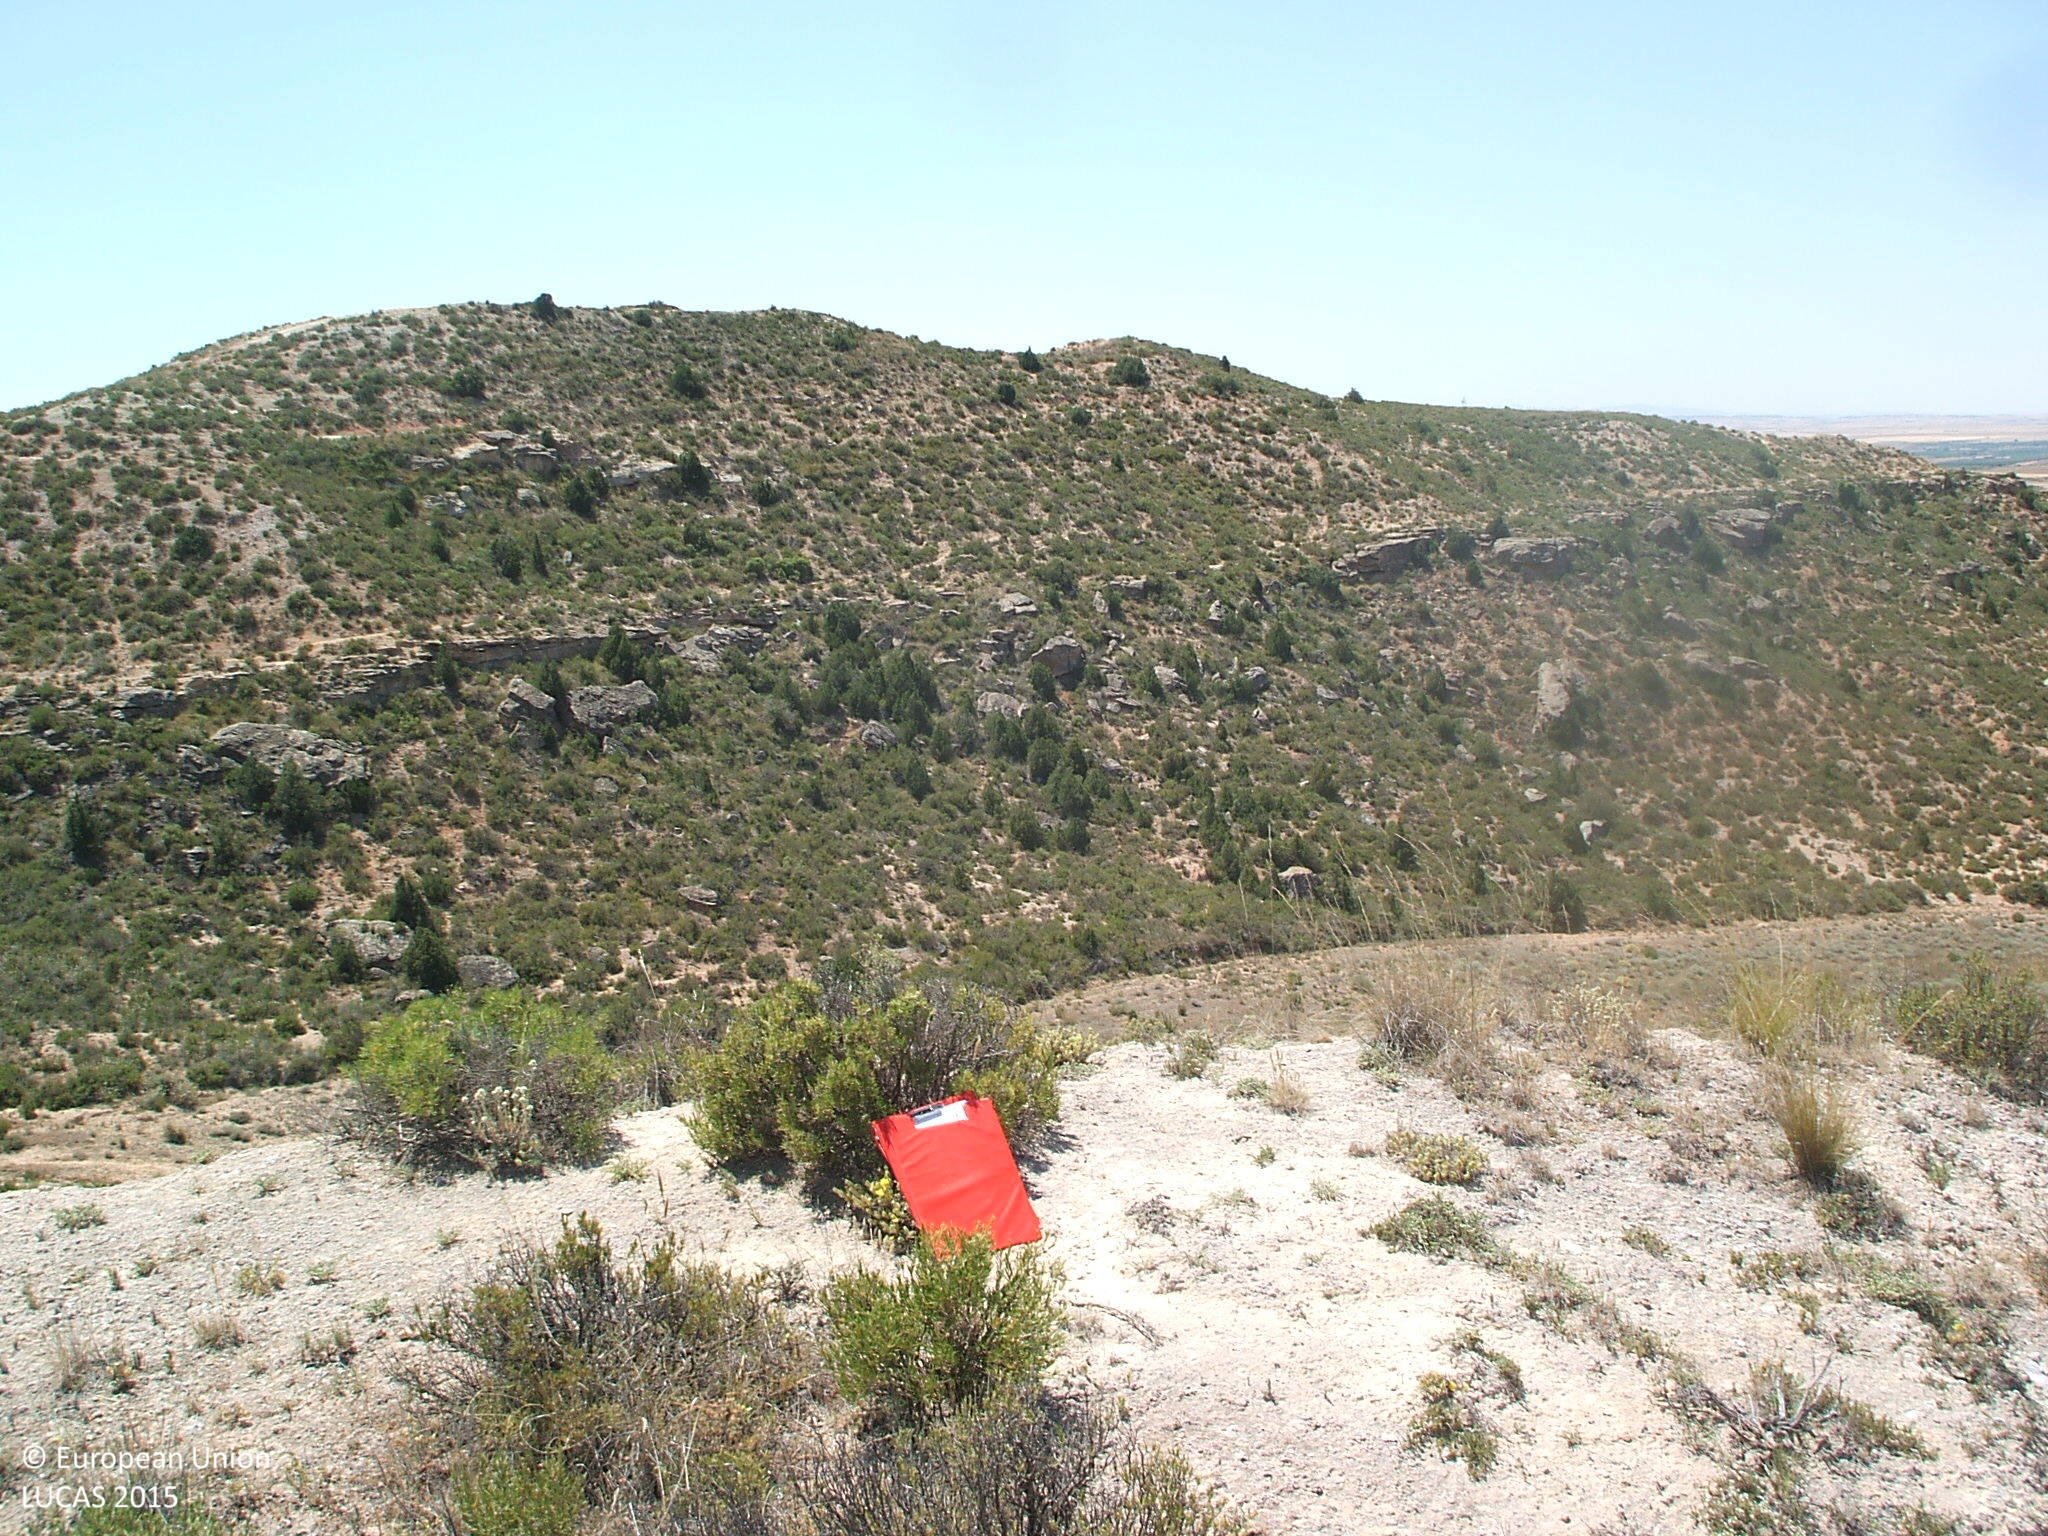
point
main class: Shrubland
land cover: Shrubland without tree cover
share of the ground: 10 - 25 %
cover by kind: consolidated bare surface 80 %, shrubs 20 %
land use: Semi-natural and natural areas not in use
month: June
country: ES
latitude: 41.0834
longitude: -0.1895
